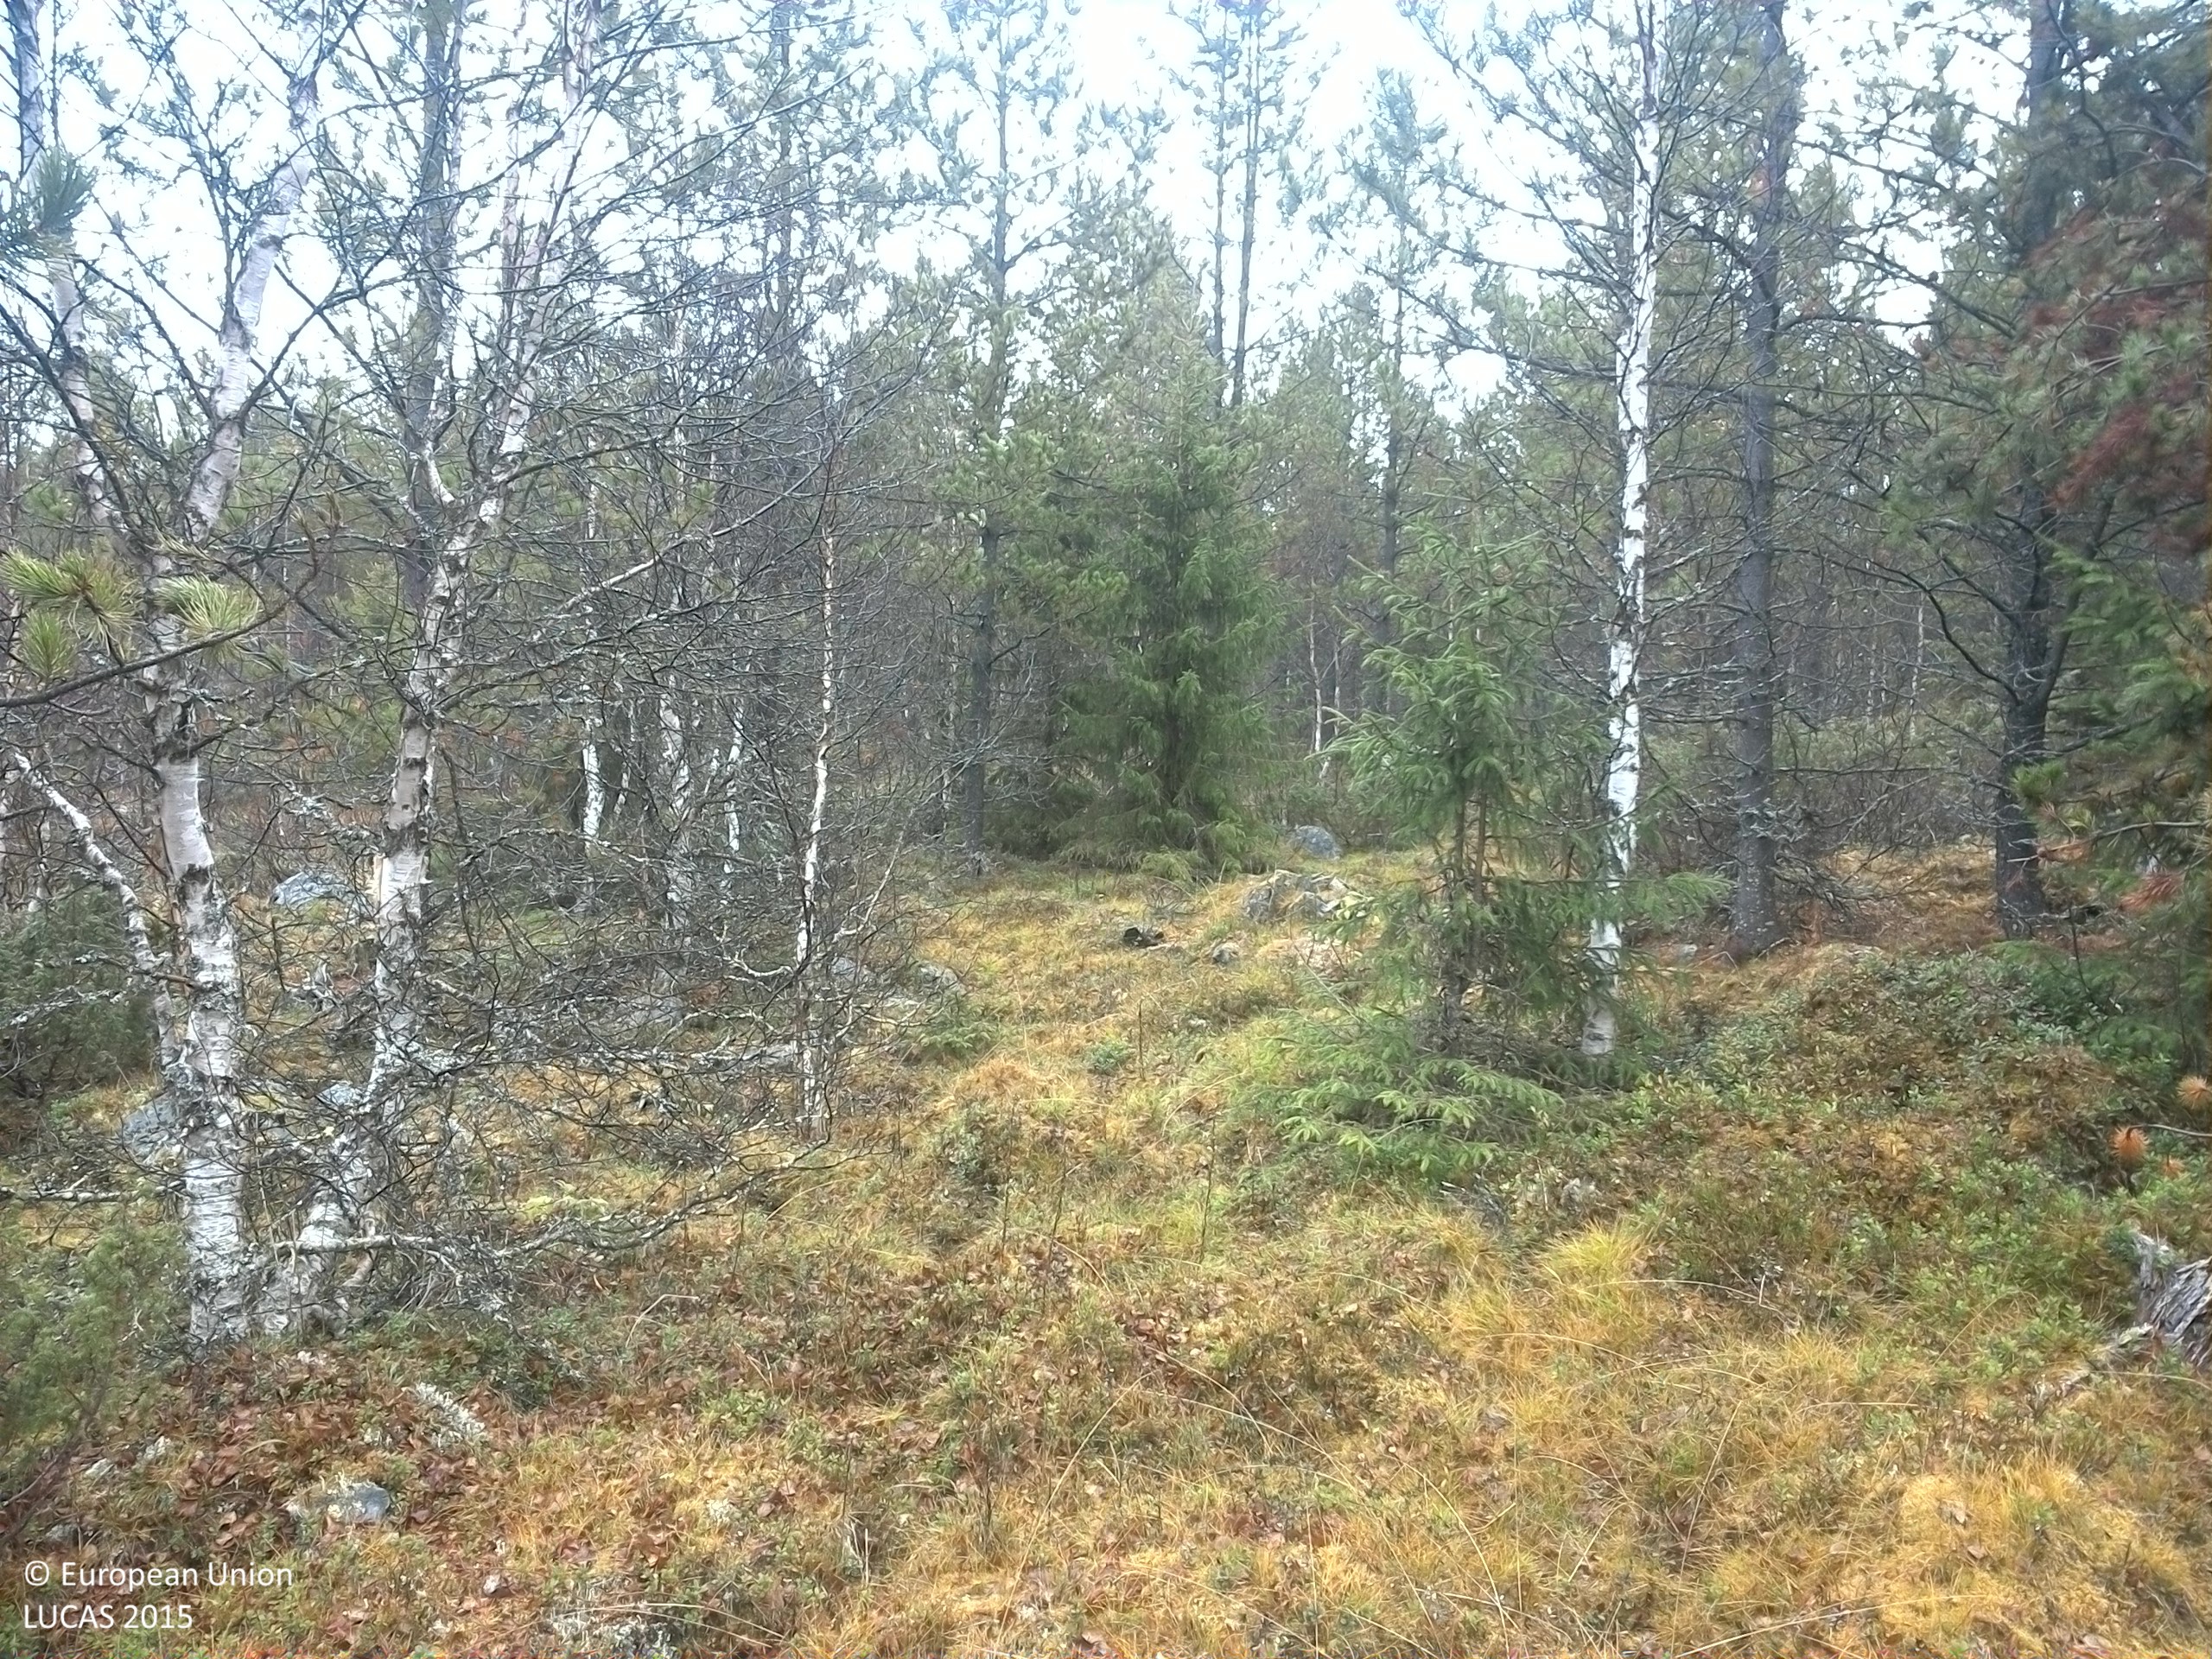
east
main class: Woodland
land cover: Pine dominated mixed woodland
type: exotic forest
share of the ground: 25 - 50 %
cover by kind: coniferous forest trees 30 %, herbaceous plants 25 %, shrubs 20 %, broadleaved forest trees 10 %, lichens and mosses 10 %, consolidated bare surface 5 %
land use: Forestry
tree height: > 5 m
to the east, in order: Pine dominated mixed woodland; Grassland without tree/shrub cover
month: October
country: SE
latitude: 64.3211
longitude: 15.4935
